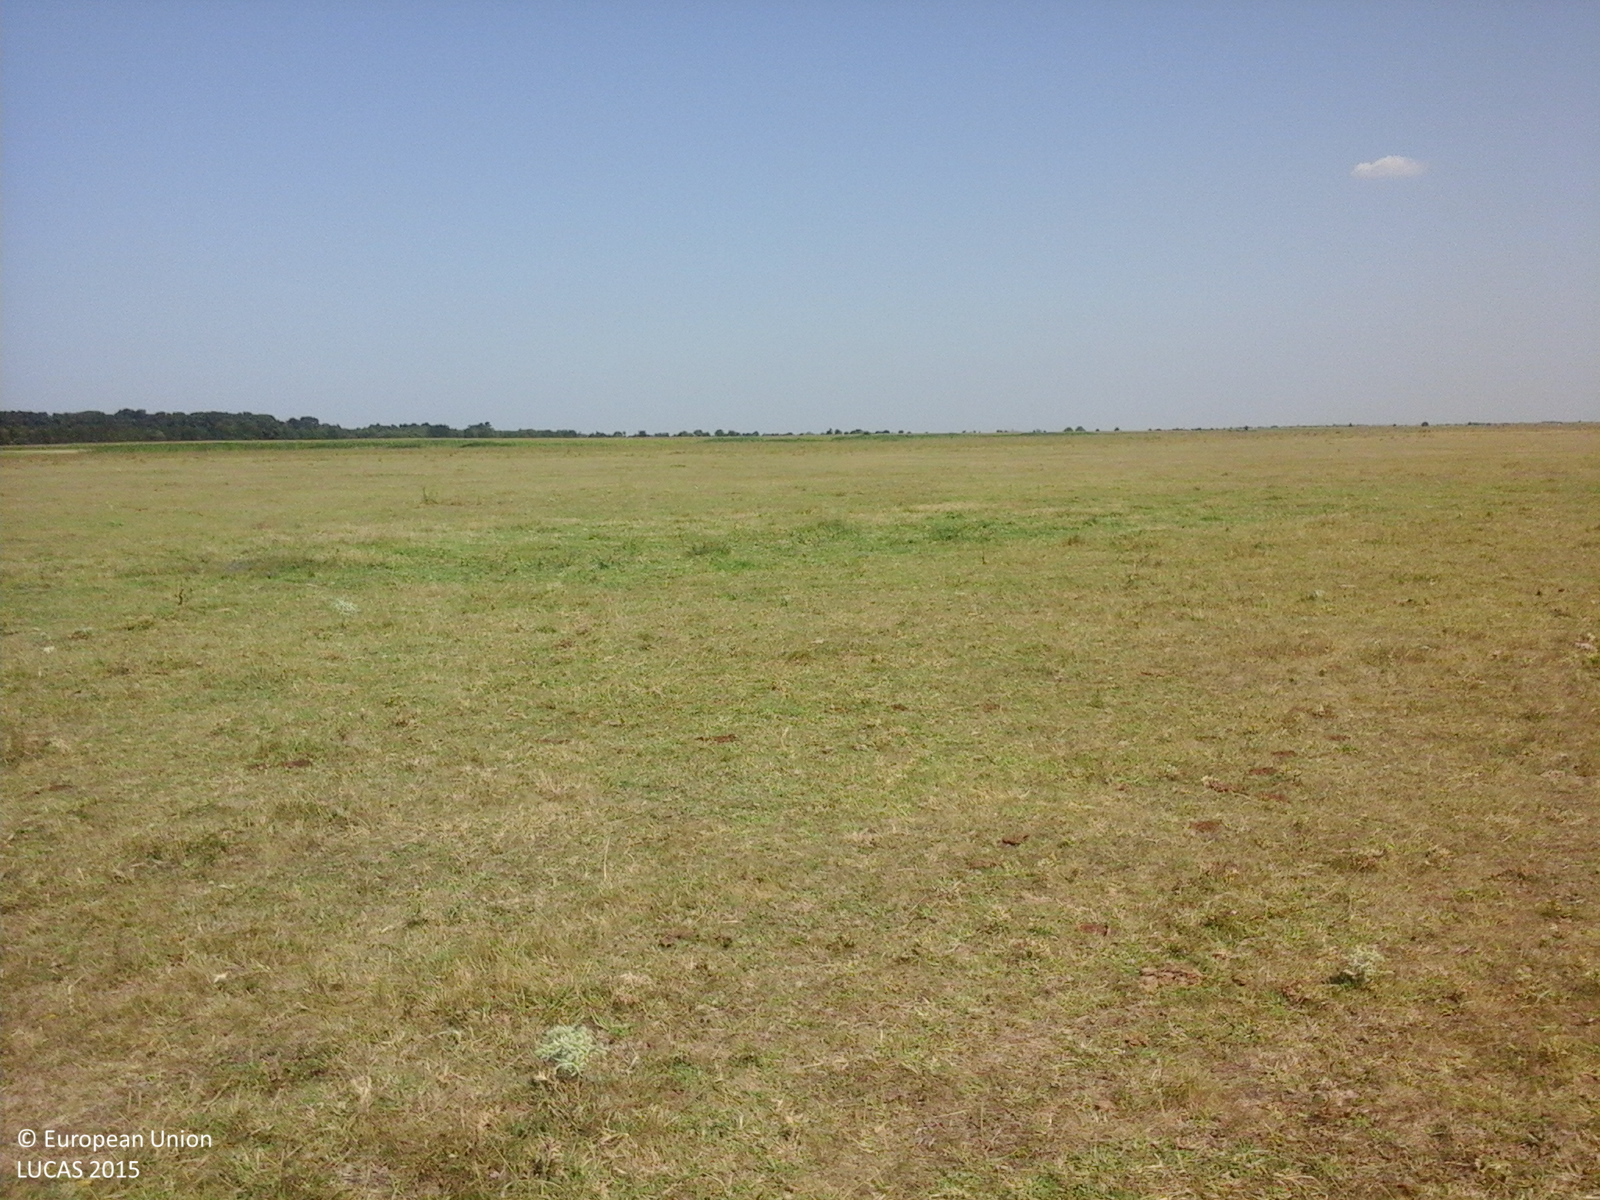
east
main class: Grassland
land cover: Grassland without tree/shrub cover
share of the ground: > 75 %
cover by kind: herbaceous plants 100 %
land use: Agriculture (excluding fallow land and kitchen gardens)
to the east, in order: Grassland without tree/shrub cover
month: August
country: RO
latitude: 45.0430
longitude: 26.8242
